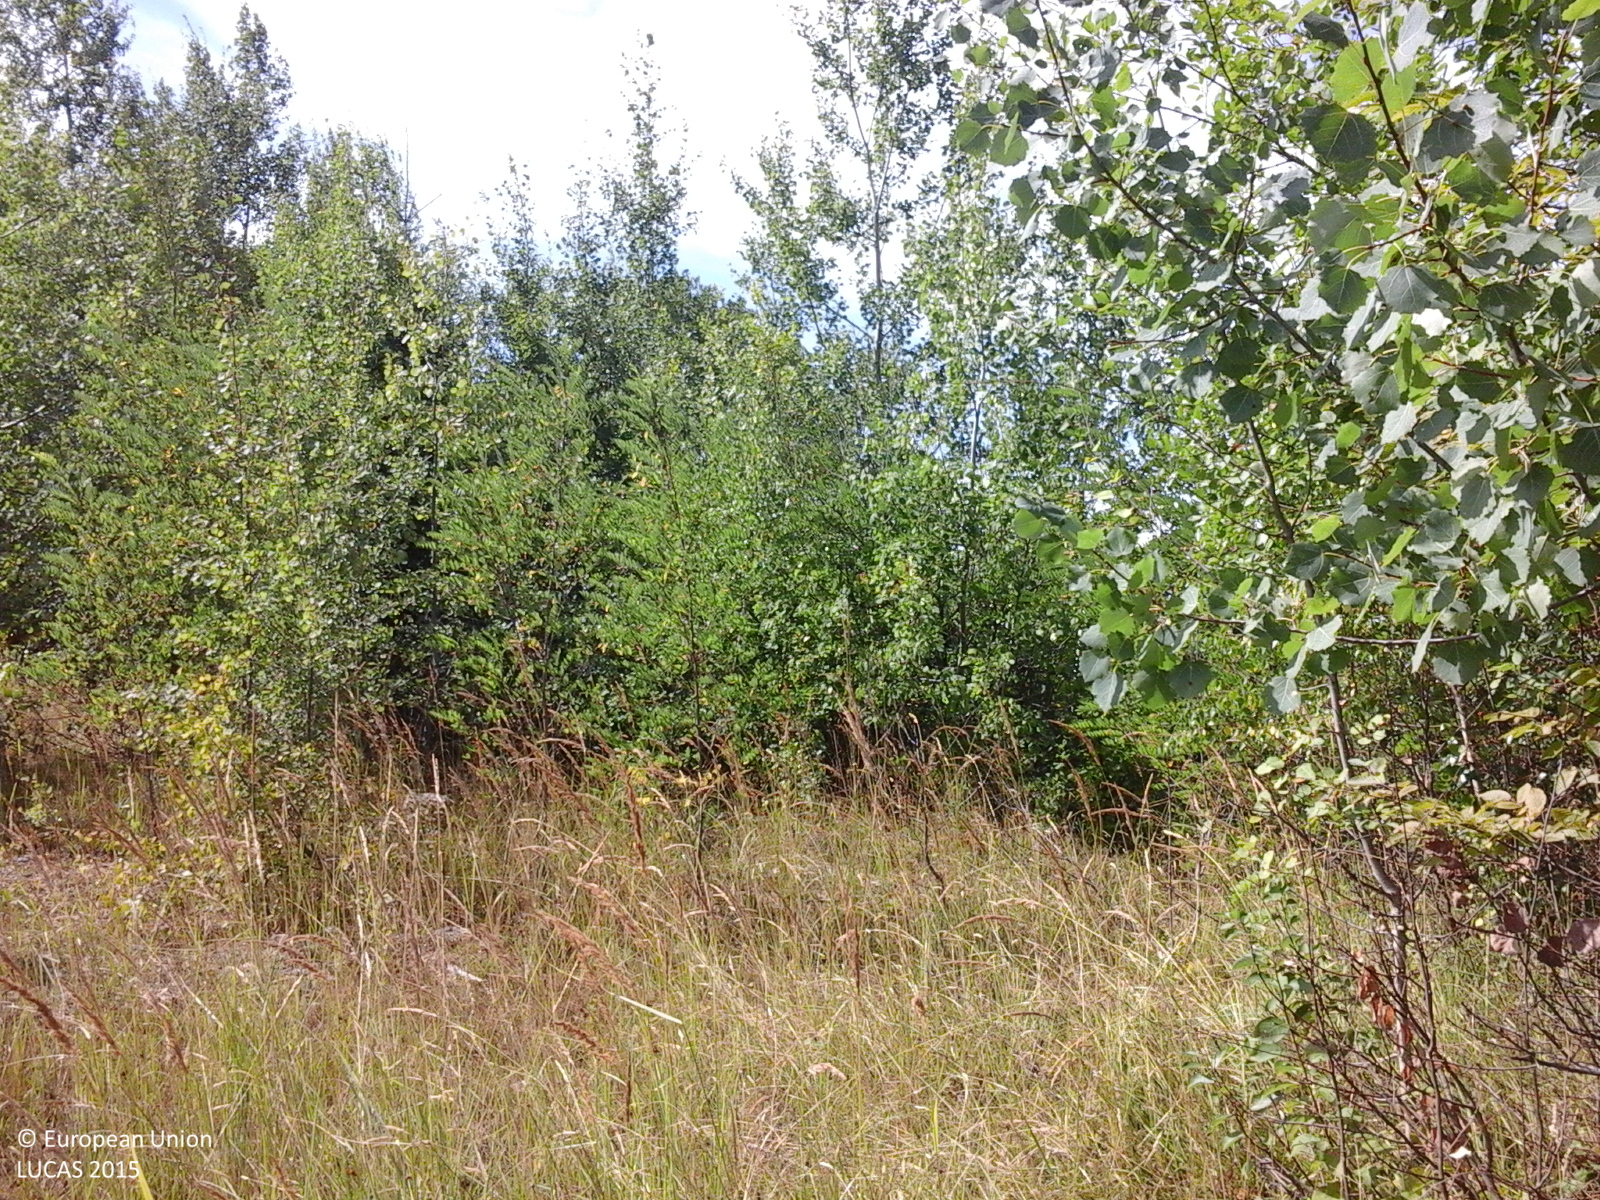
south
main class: Woodland
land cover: Broadleaved woodland
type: beech forest
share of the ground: > 75 %
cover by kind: broadleaved forest trees 100 %
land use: Forestry
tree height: > 5 m
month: August
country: RO
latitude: 45.0552
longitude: 21.8300
